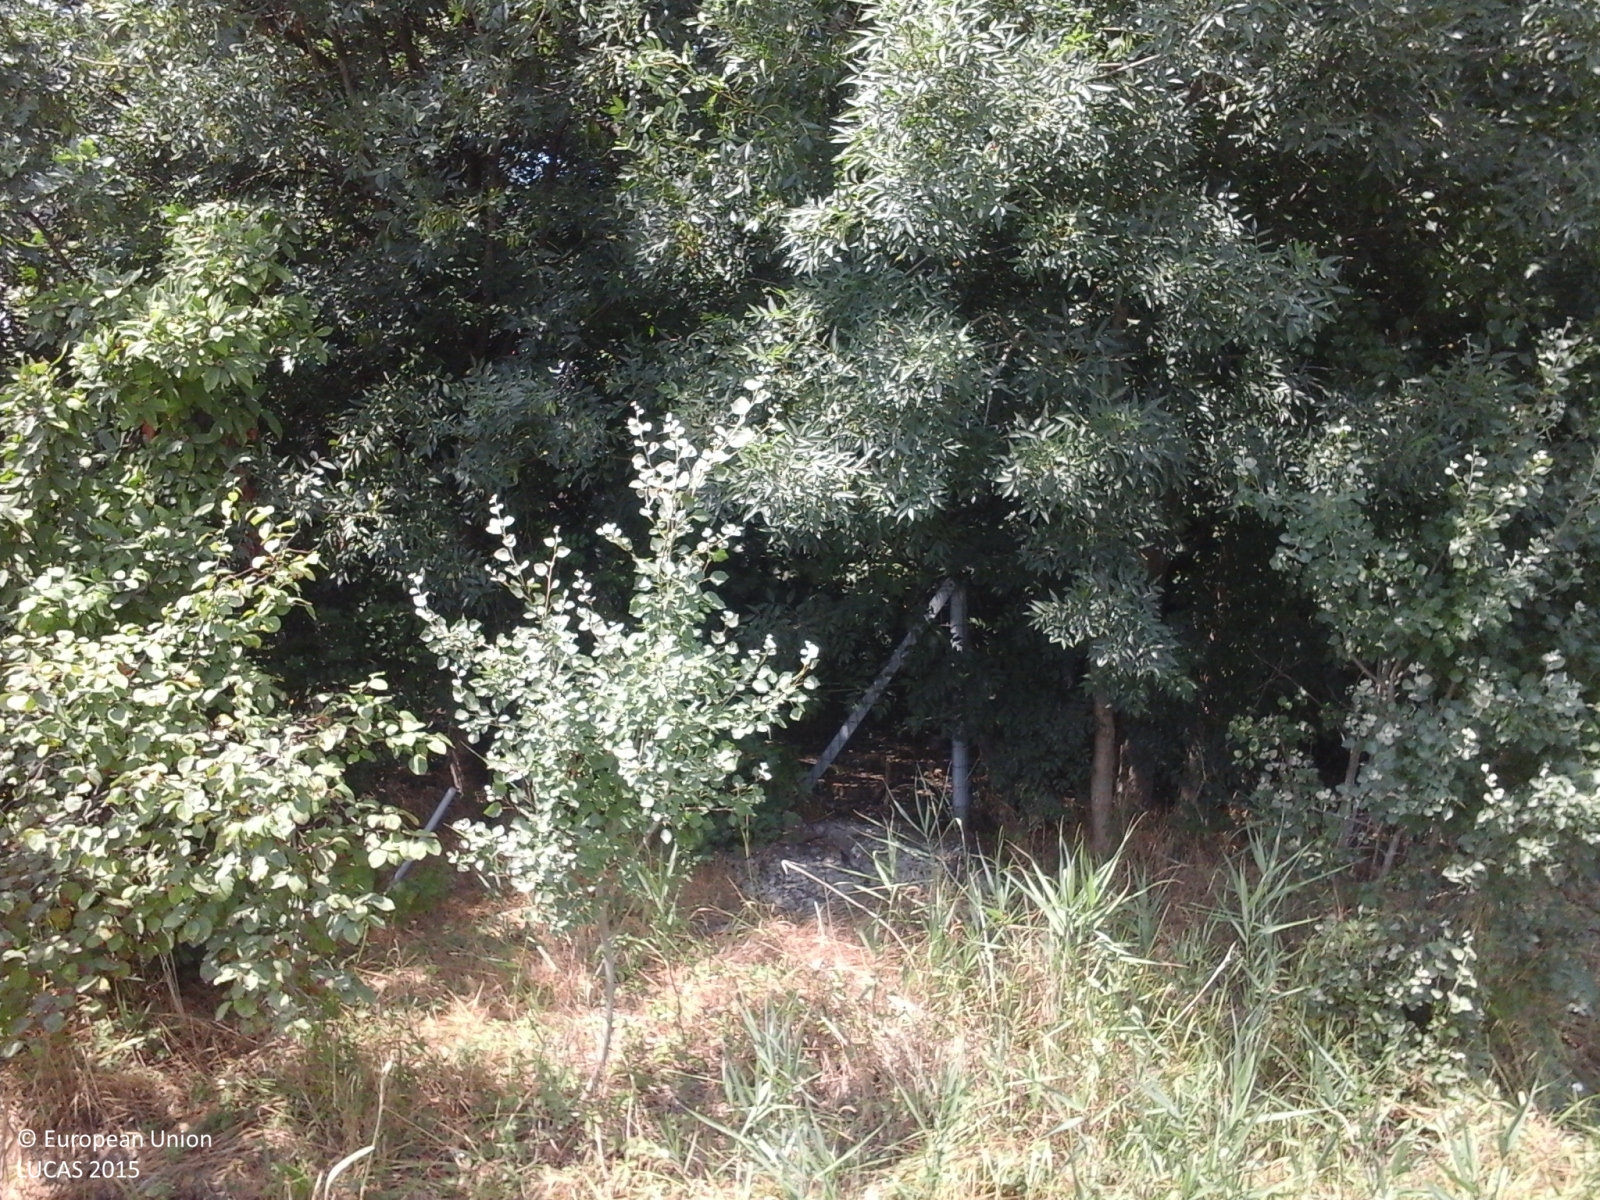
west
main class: Woodland
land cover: Broadleaved woodland
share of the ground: > 75 %
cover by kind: broadleaved forest trees 100 %
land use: Residential
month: June
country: IT
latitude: 44.8137
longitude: 11.0979
